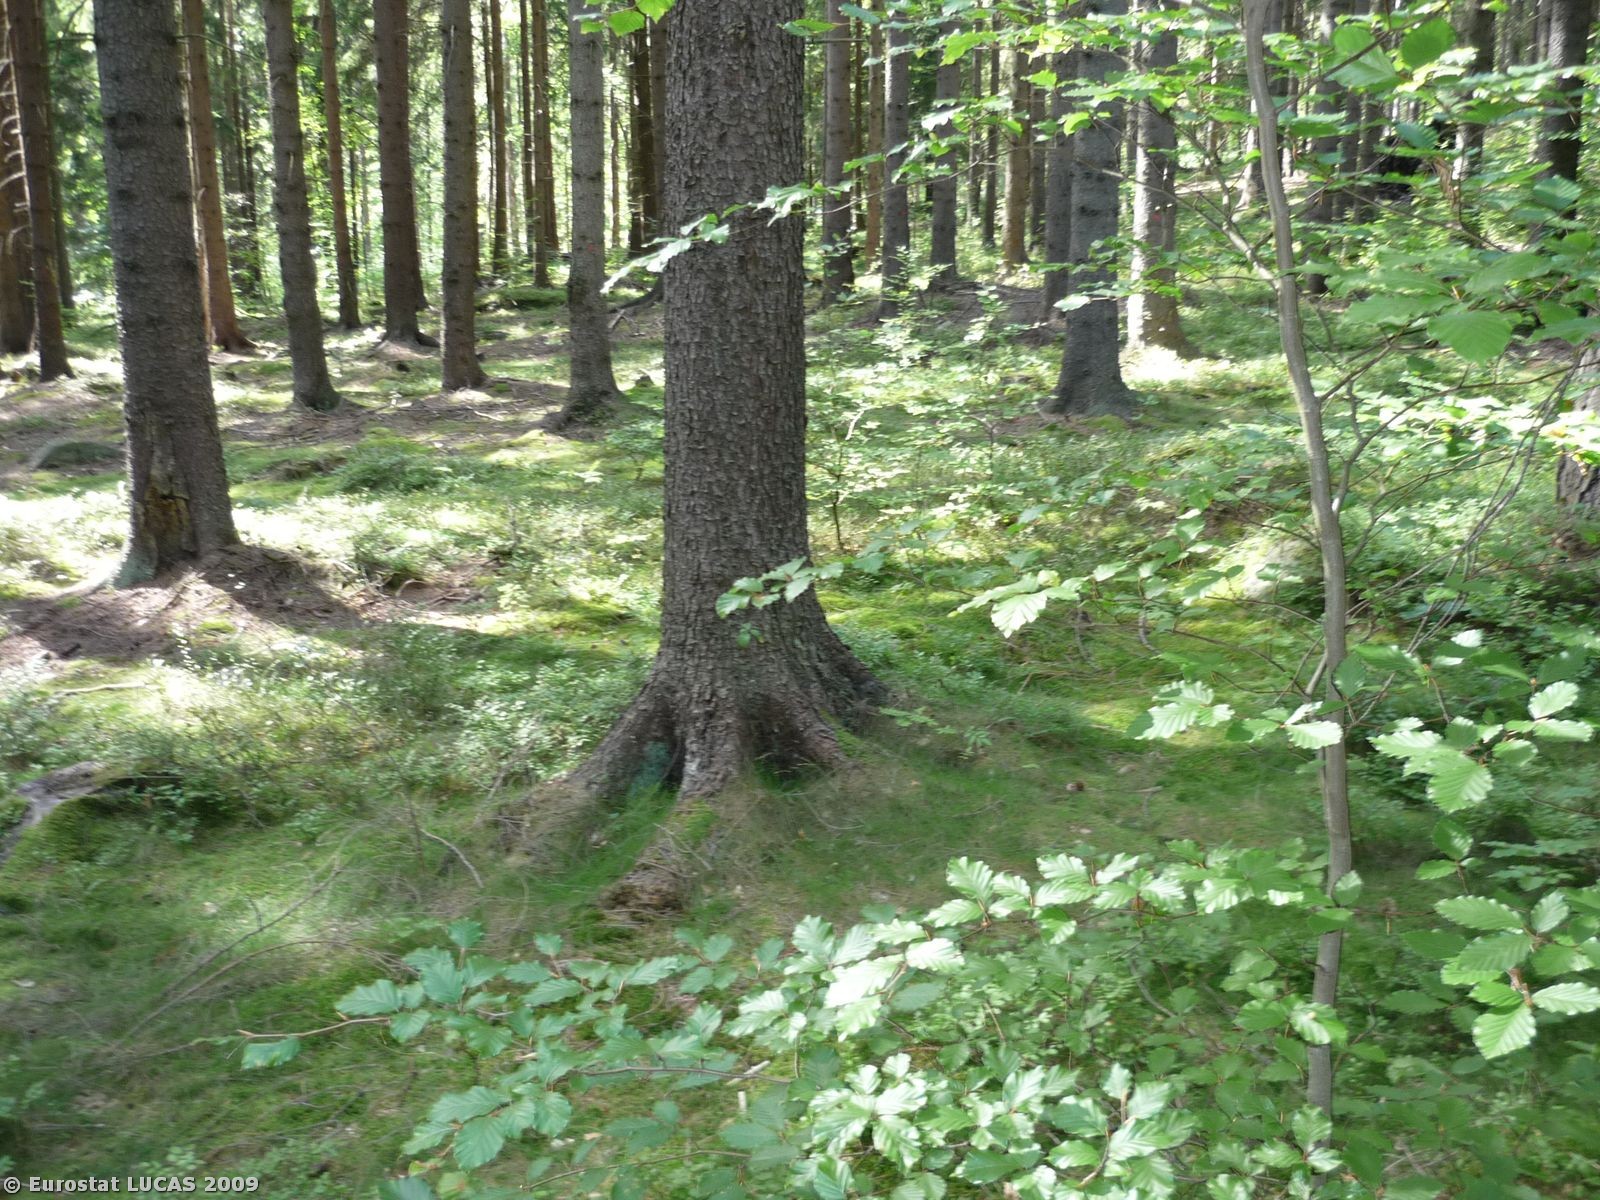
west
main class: Woodland
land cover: Coniferous woodland
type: hemiboreal forest and nemoral coniferous forest and mixed broadleaved-coniferous forest
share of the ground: > 75 %
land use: Forestry
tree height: > 5 m
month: August
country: PL
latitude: 50.8597
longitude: 15.5593
